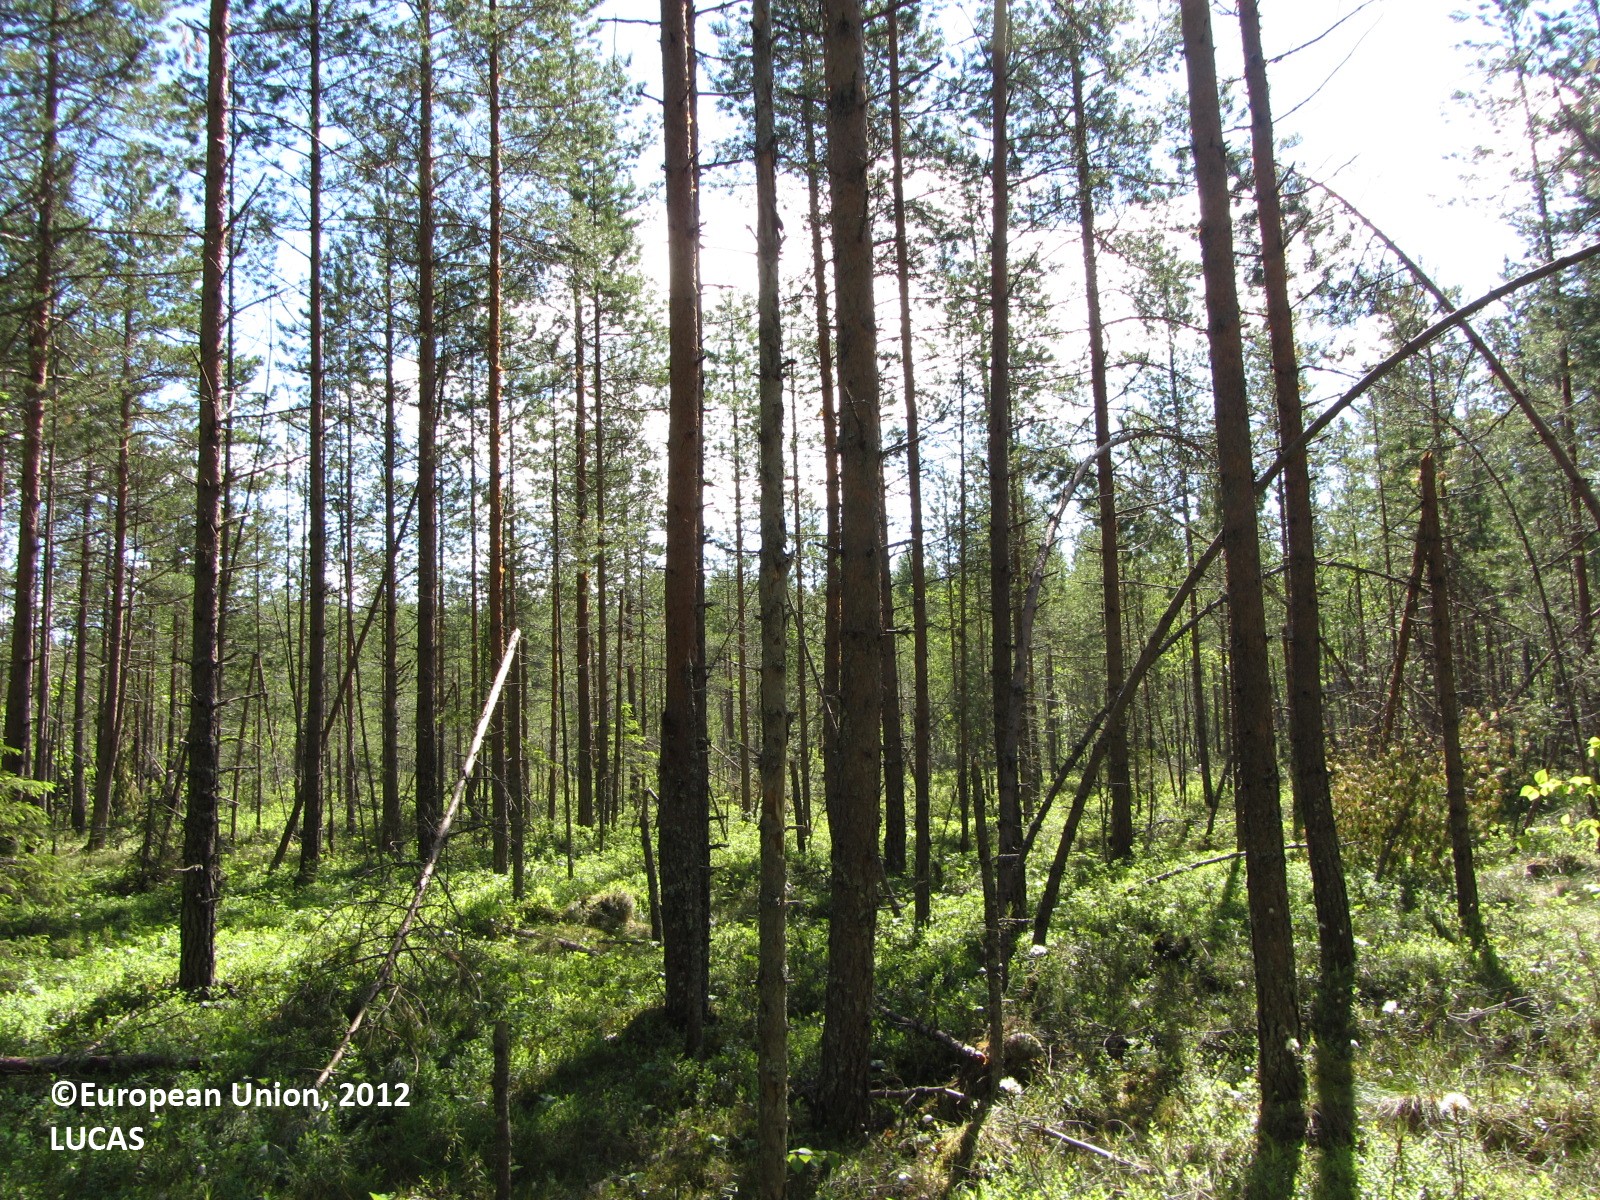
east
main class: Woodland
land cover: Pine dominated mixed woodland
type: boreal forest
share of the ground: 50 - 75 %
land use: Forestry
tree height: > 5 m
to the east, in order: Pine dominated mixed woodland; Pine dominated coniferous woodland; Ditches and canals; Pine dominated coniferous woodland; Ditches and canals; Broadleaved woodland; Ditches and canals; Shrubland with sparse tree cover; Spruce dominated mixed woodland; Shrubland with sparse tree cover; Other mixed woodland
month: June
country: FI
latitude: 62.1484
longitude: 25.3658
